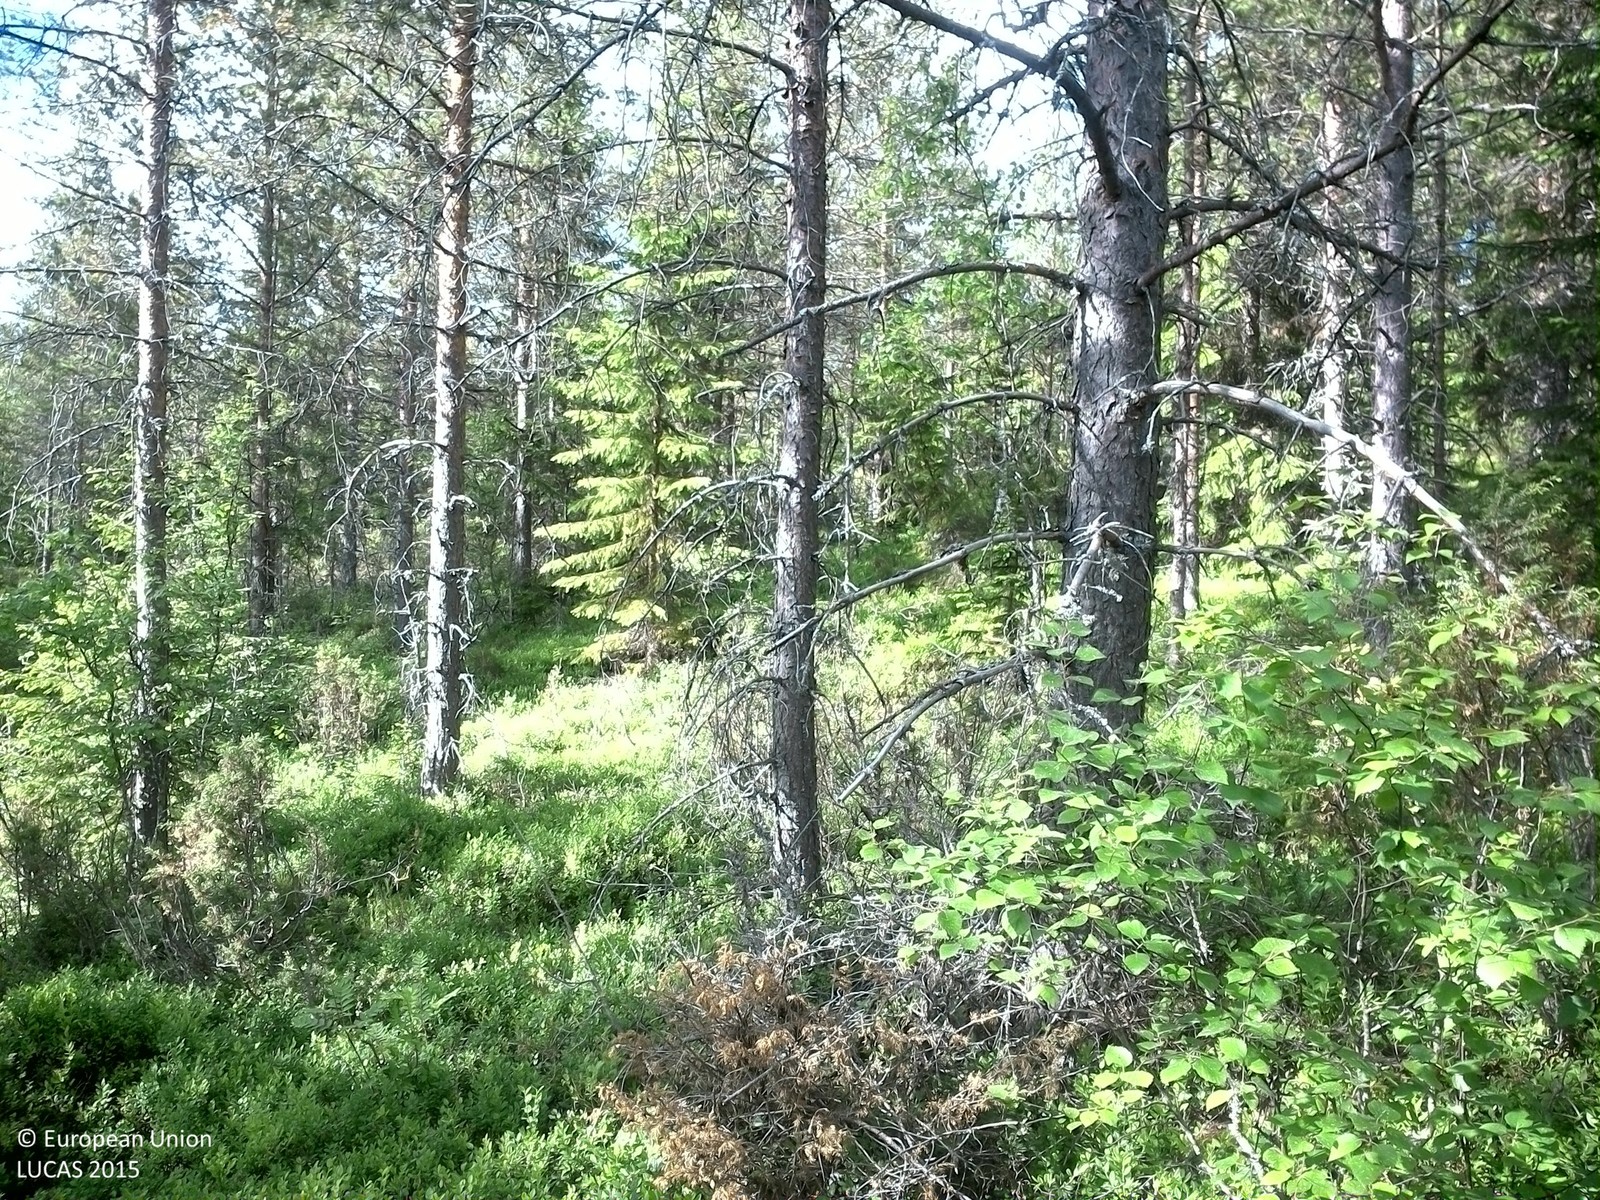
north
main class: Woodland
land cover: Spruce dominated coniferous woodland
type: boreal forest
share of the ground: 50 - 75 %
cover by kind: coniferous forest trees 50 %, shrubs 40 %, broadleaved forest trees 10 %
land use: Forestry
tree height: > 5 m
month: June
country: SE
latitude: 62.7948
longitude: 17.7233
